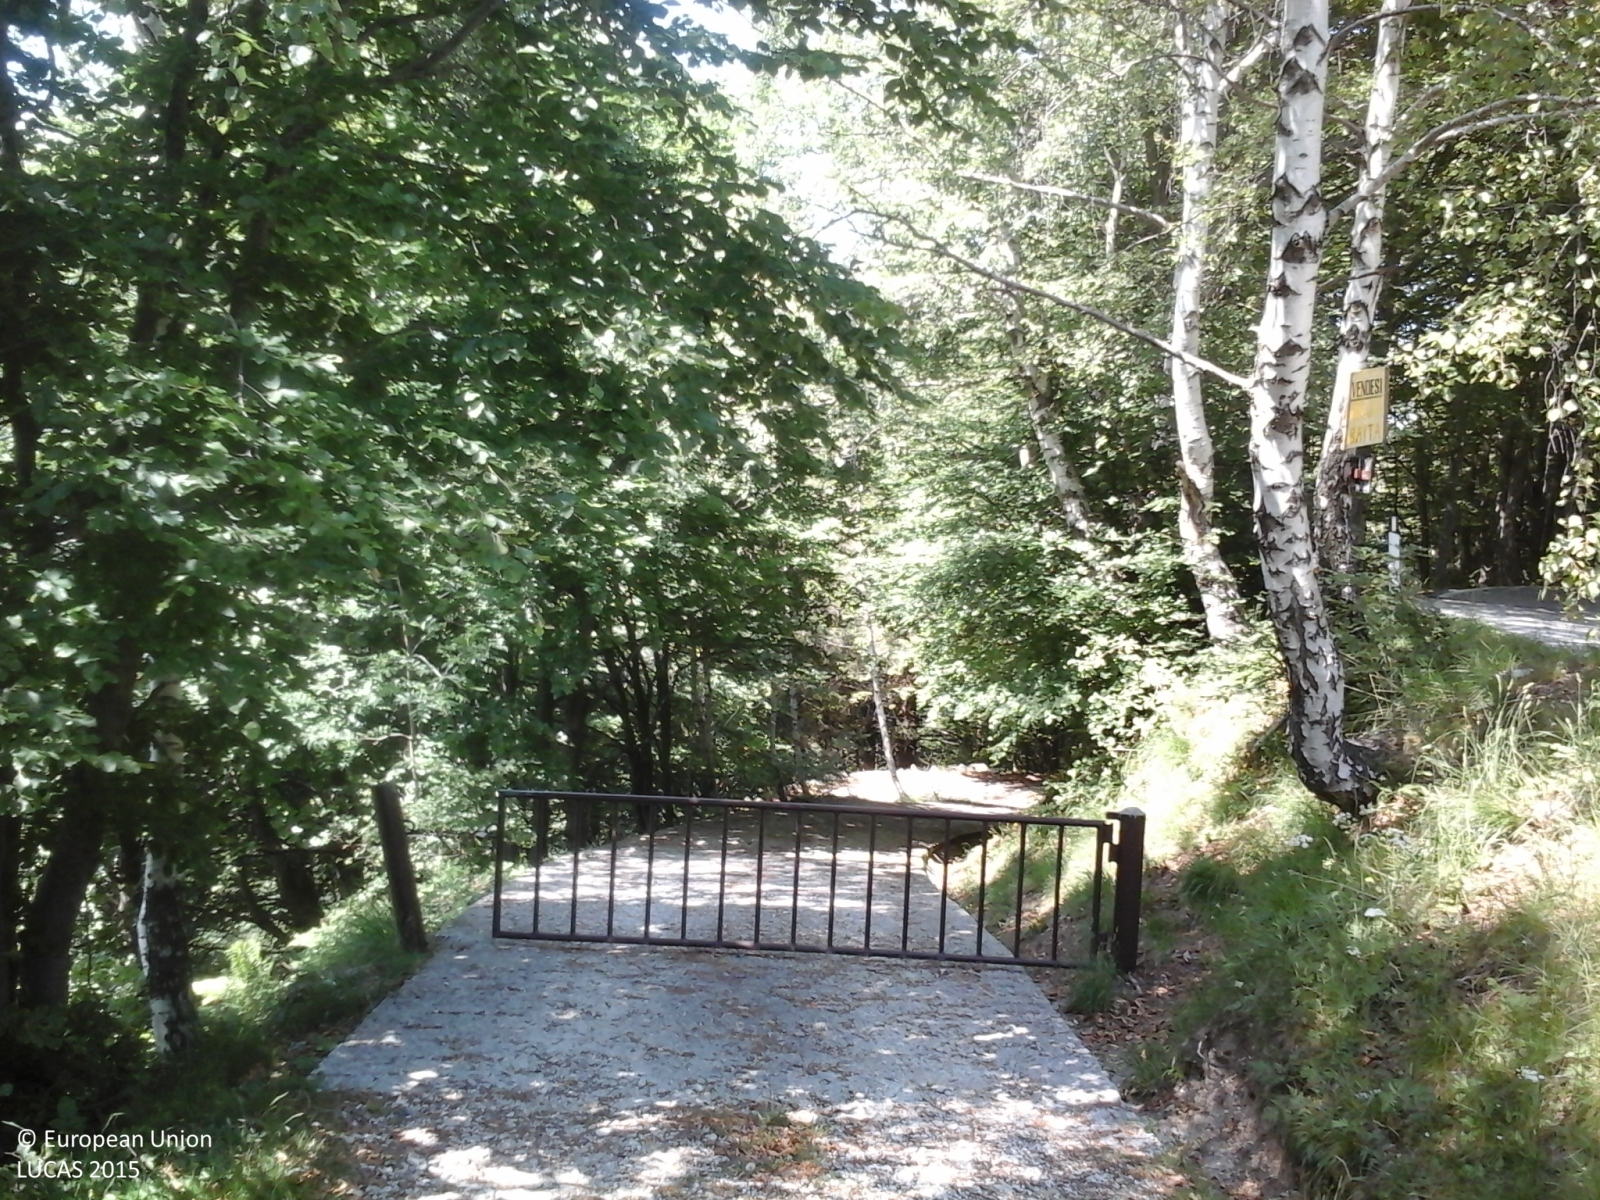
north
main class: Woodland
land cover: Broadleaved woodland
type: thermophilous deciduous forest
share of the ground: > 75 %
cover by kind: broadleaved forest trees 100 %
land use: Forestry
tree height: > 5 m
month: June
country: IT
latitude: 46.0180
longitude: 8.6199
